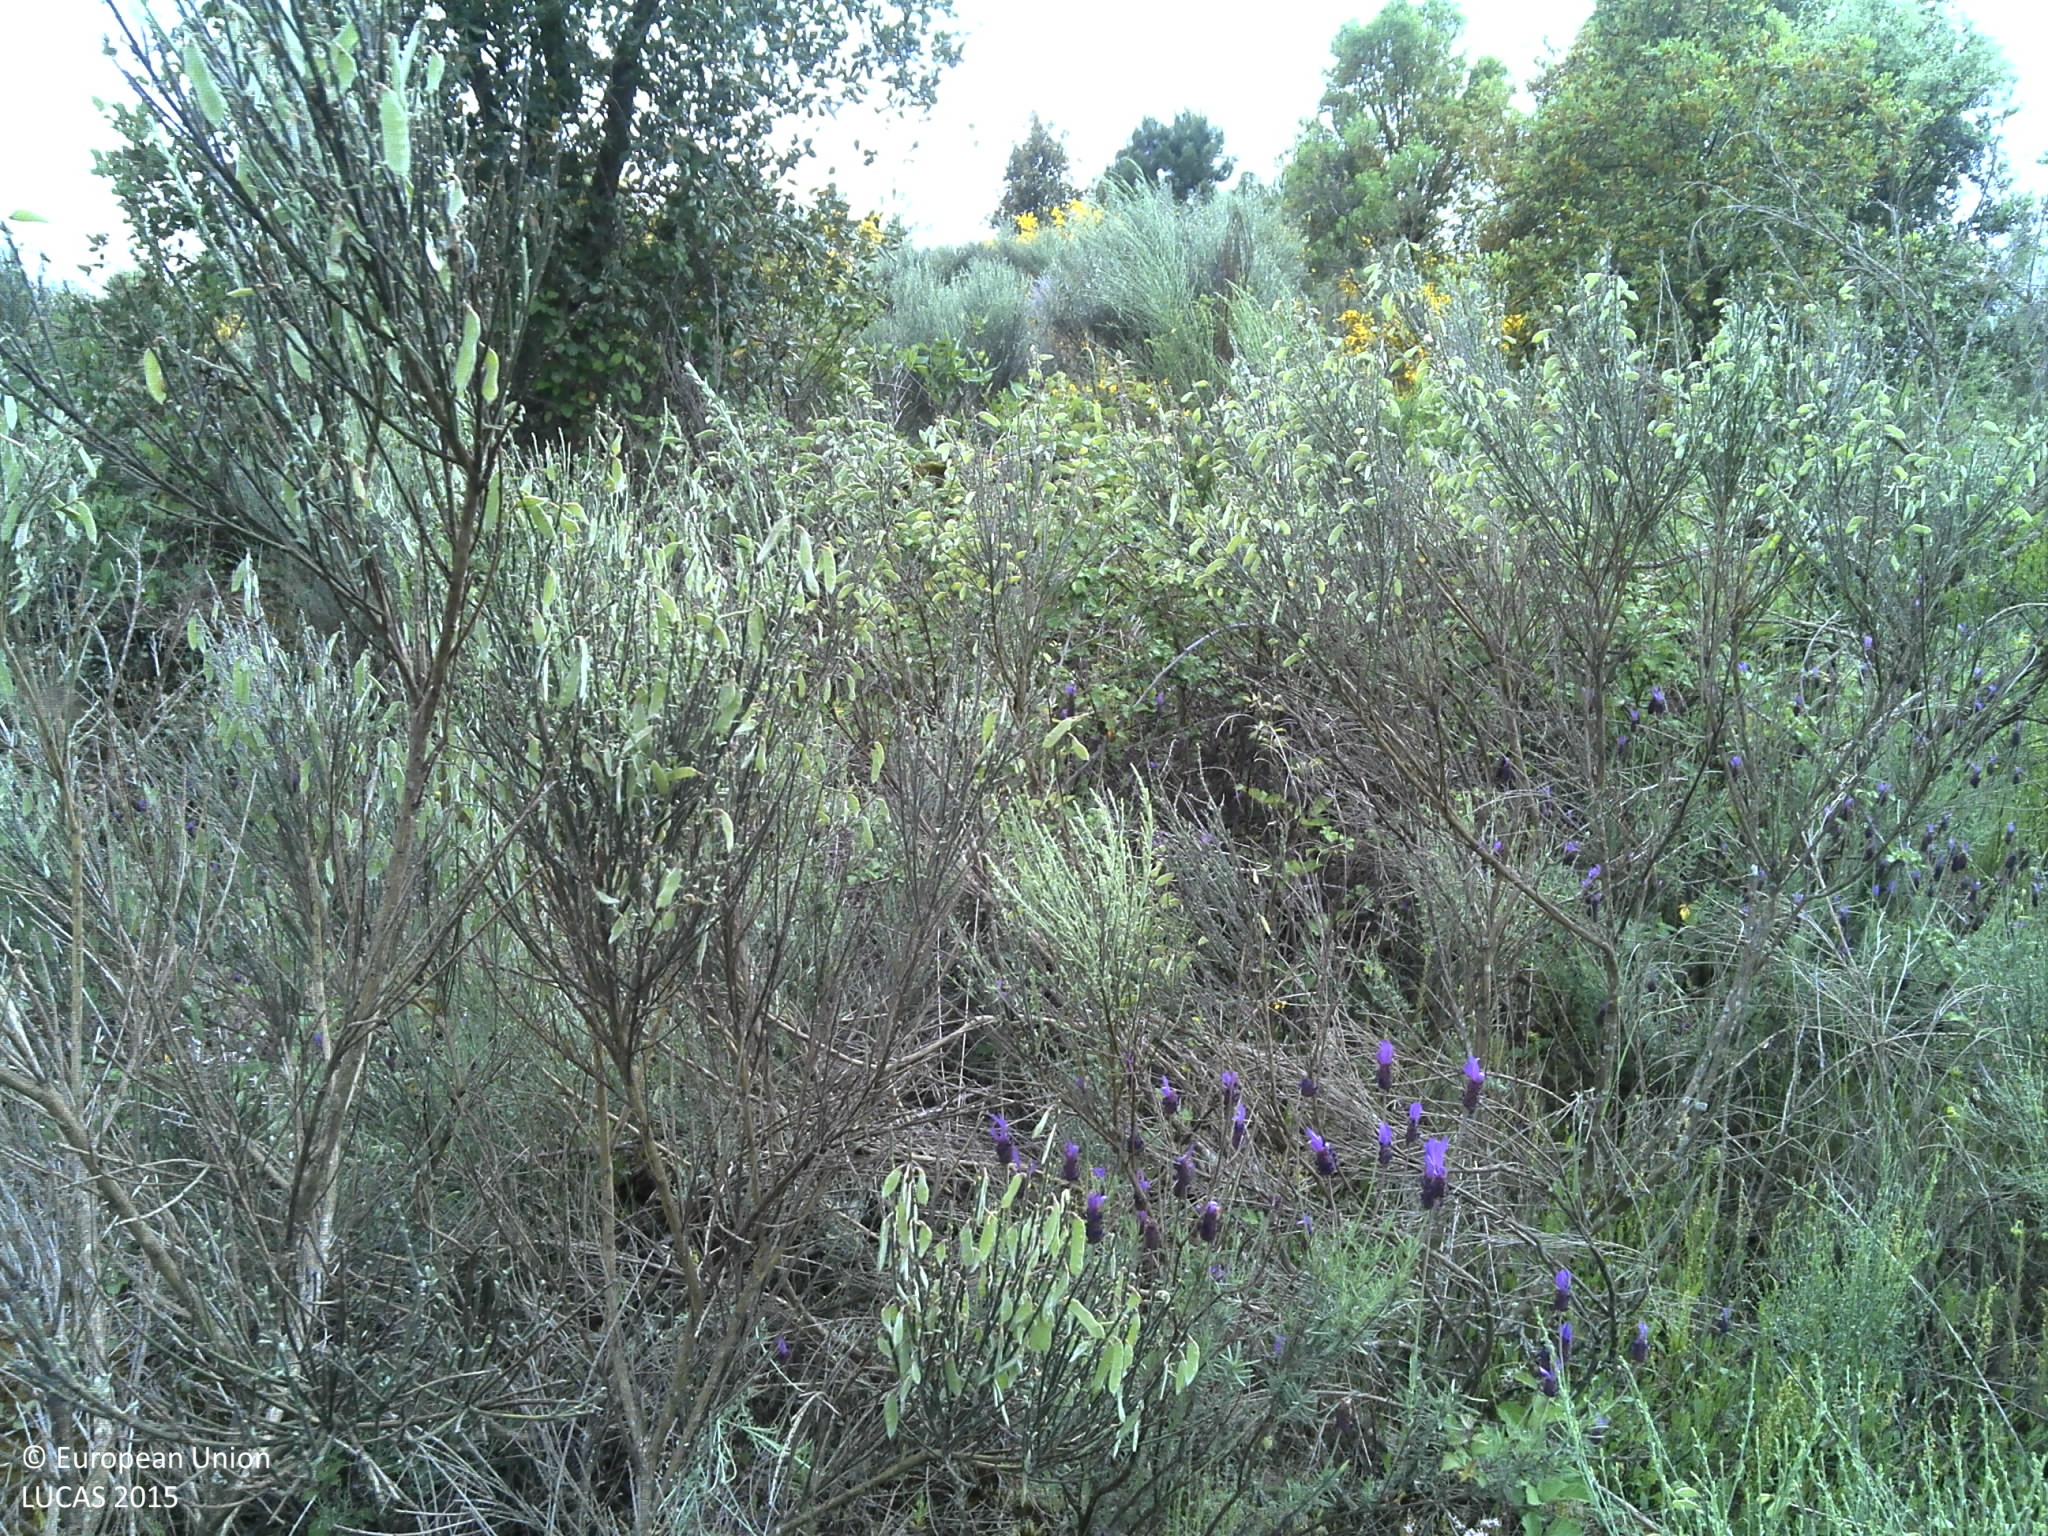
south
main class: Shrubland
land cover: Shrubland with sparse tree cover
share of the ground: > 75 %
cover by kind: shrubs 90 %, broadleaved forest trees 5 %, unconsolidated bare surface 5 %
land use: Abandoned areas
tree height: > 5 m
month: May
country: PT
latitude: 41.6731
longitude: -7.1656
